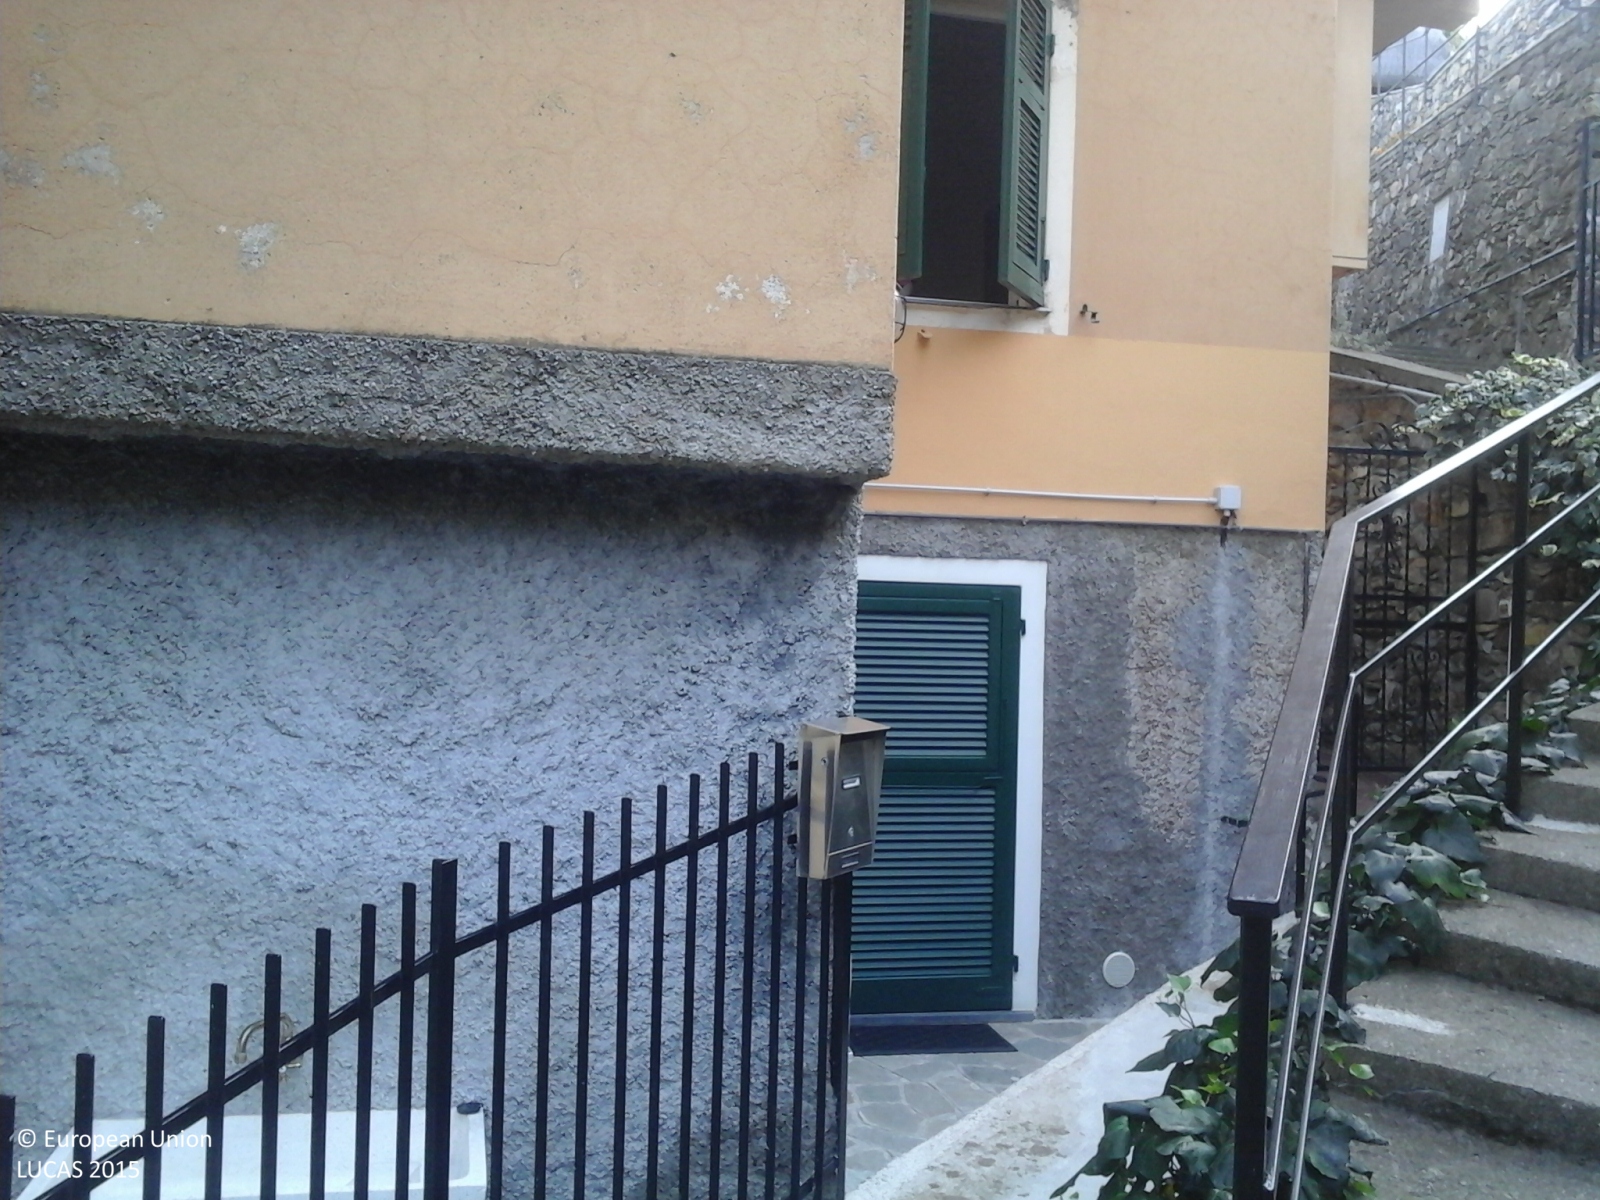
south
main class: Woodland
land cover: Broadleaved woodland
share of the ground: > 75 %
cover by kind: broadleaved forest trees 70 %, herbaceous plants 15 %, shrubs 10 %, coniferous forest trees 5 %
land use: Residential
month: August
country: IT
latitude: 44.3650
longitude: 9.1362
